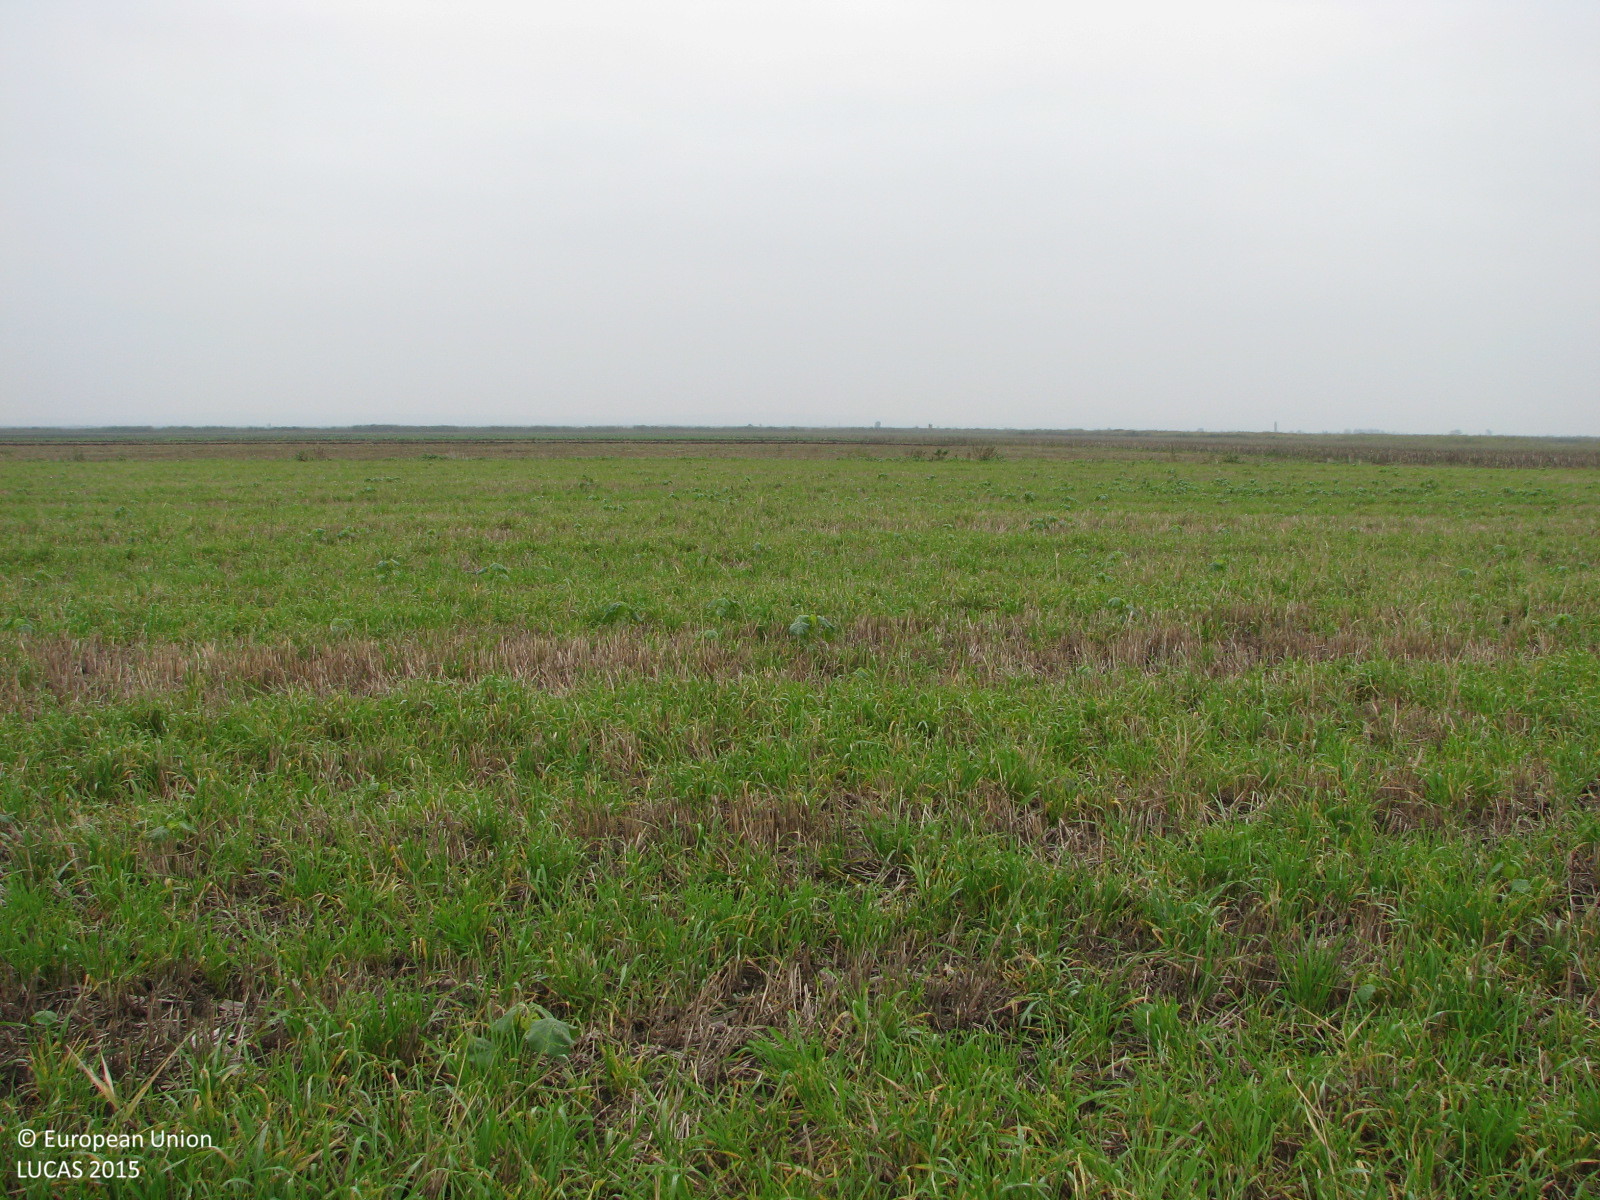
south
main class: Cropland
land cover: Common wheat
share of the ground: > 75 %
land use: Agriculture (excluding fallow land and kitchen gardens)
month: October
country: BG
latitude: 42.6287
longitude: 26.7441
